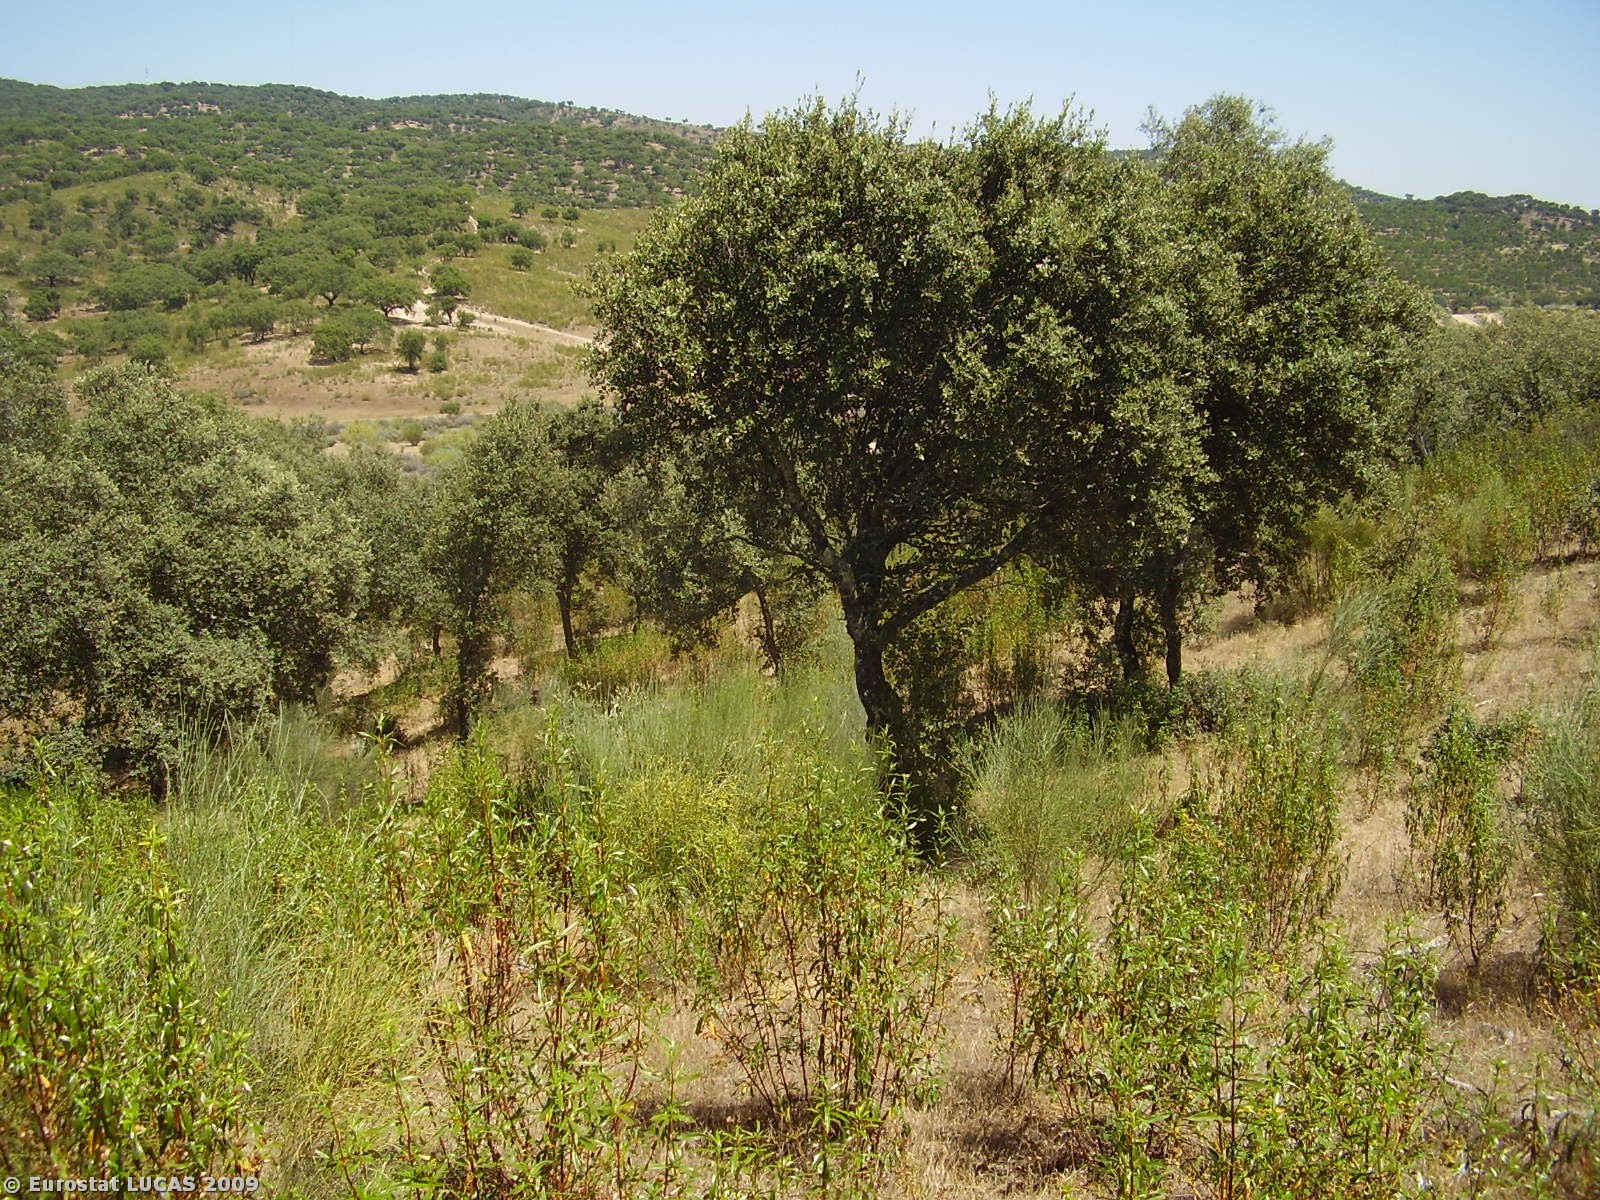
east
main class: Woodland
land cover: Broadleaved woodland
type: broadleaved evergreen forest
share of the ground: 25 - 50 %
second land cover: Shrubland with sparse tree cover
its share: 50 - 75 %
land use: Forestry
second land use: Fallow land
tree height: > 5 m
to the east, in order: Broadleaved woodland; Shrubland with sparse tree cover; Broadleaved woodland; Shrubland without tree cover; Tracks; Shrubland without tree cover; Single bushes/trees; Shrubland without tree cover
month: July
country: PT
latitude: 38.7541
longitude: -7.7012
